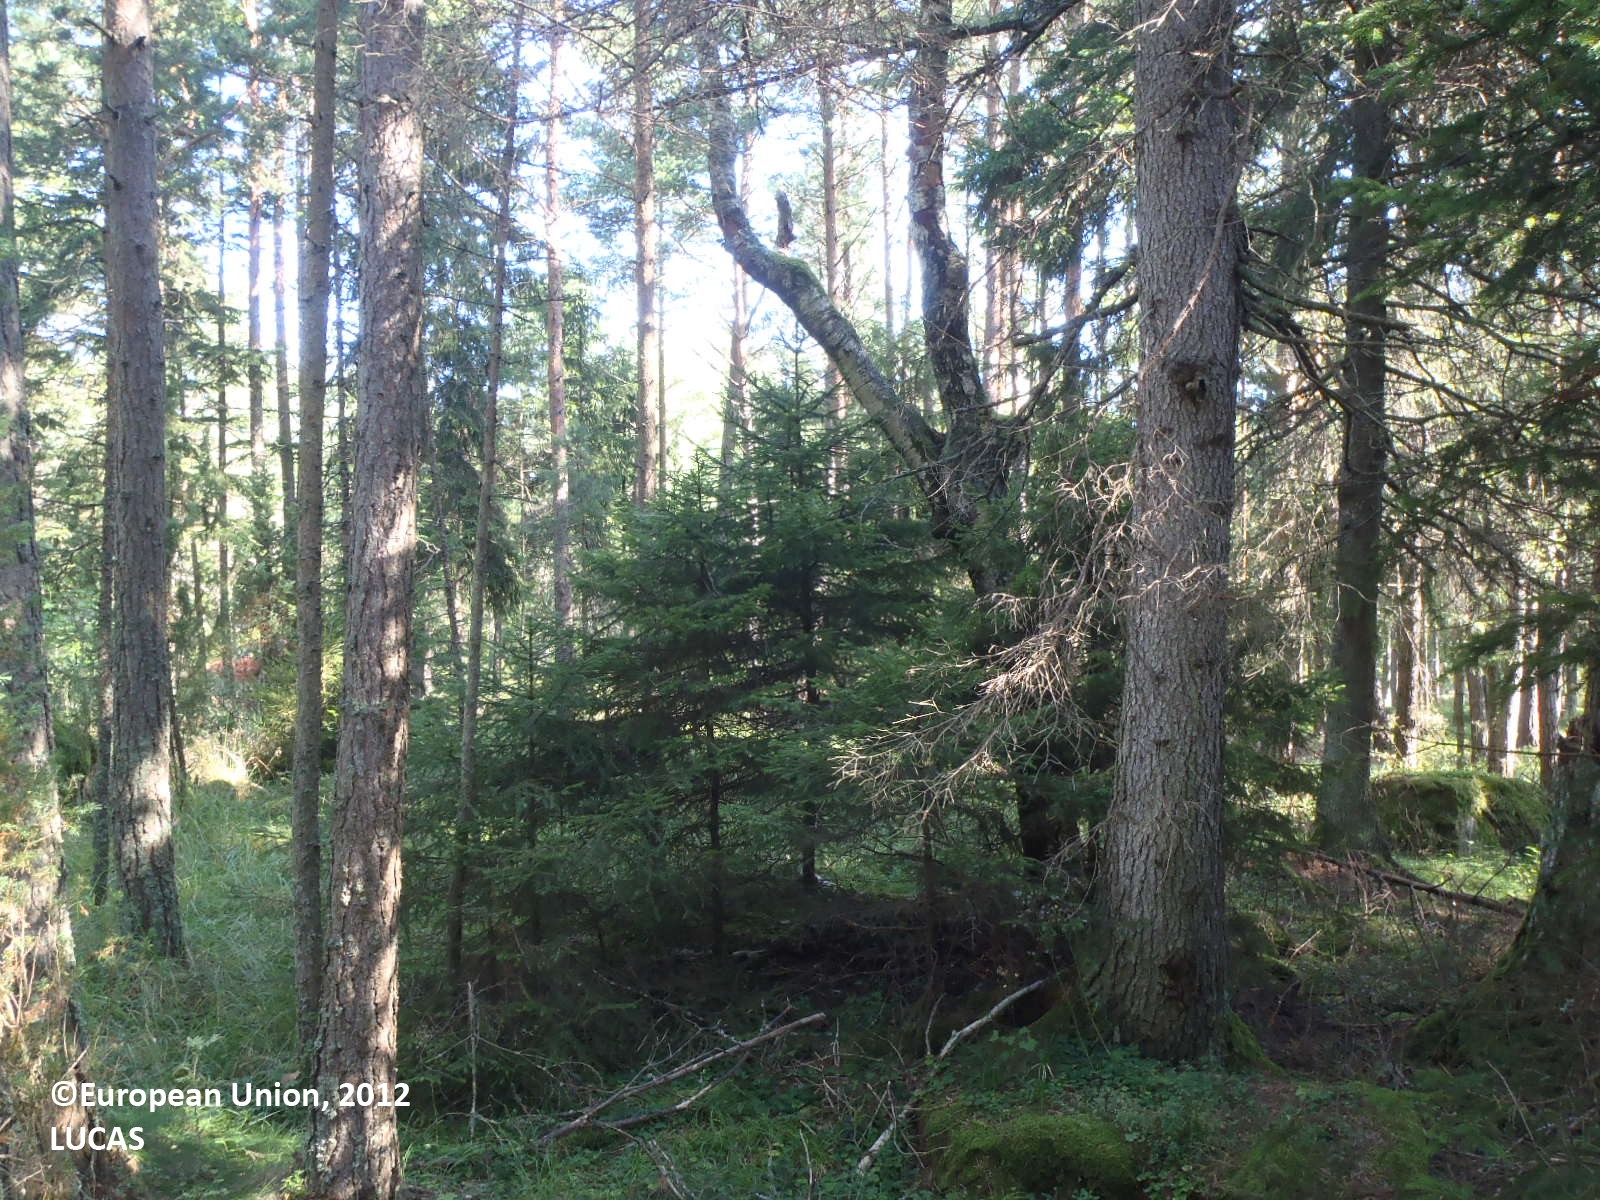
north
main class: Woodland
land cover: Pine dominated coniferous woodland
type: hemiboreal forest and nemoral coniferous forest and mixed broadleaved-coniferous forest
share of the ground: > 75 %
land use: Forestry
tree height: > 5 m
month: August
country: FI
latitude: 60.3622
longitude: 20.1044
